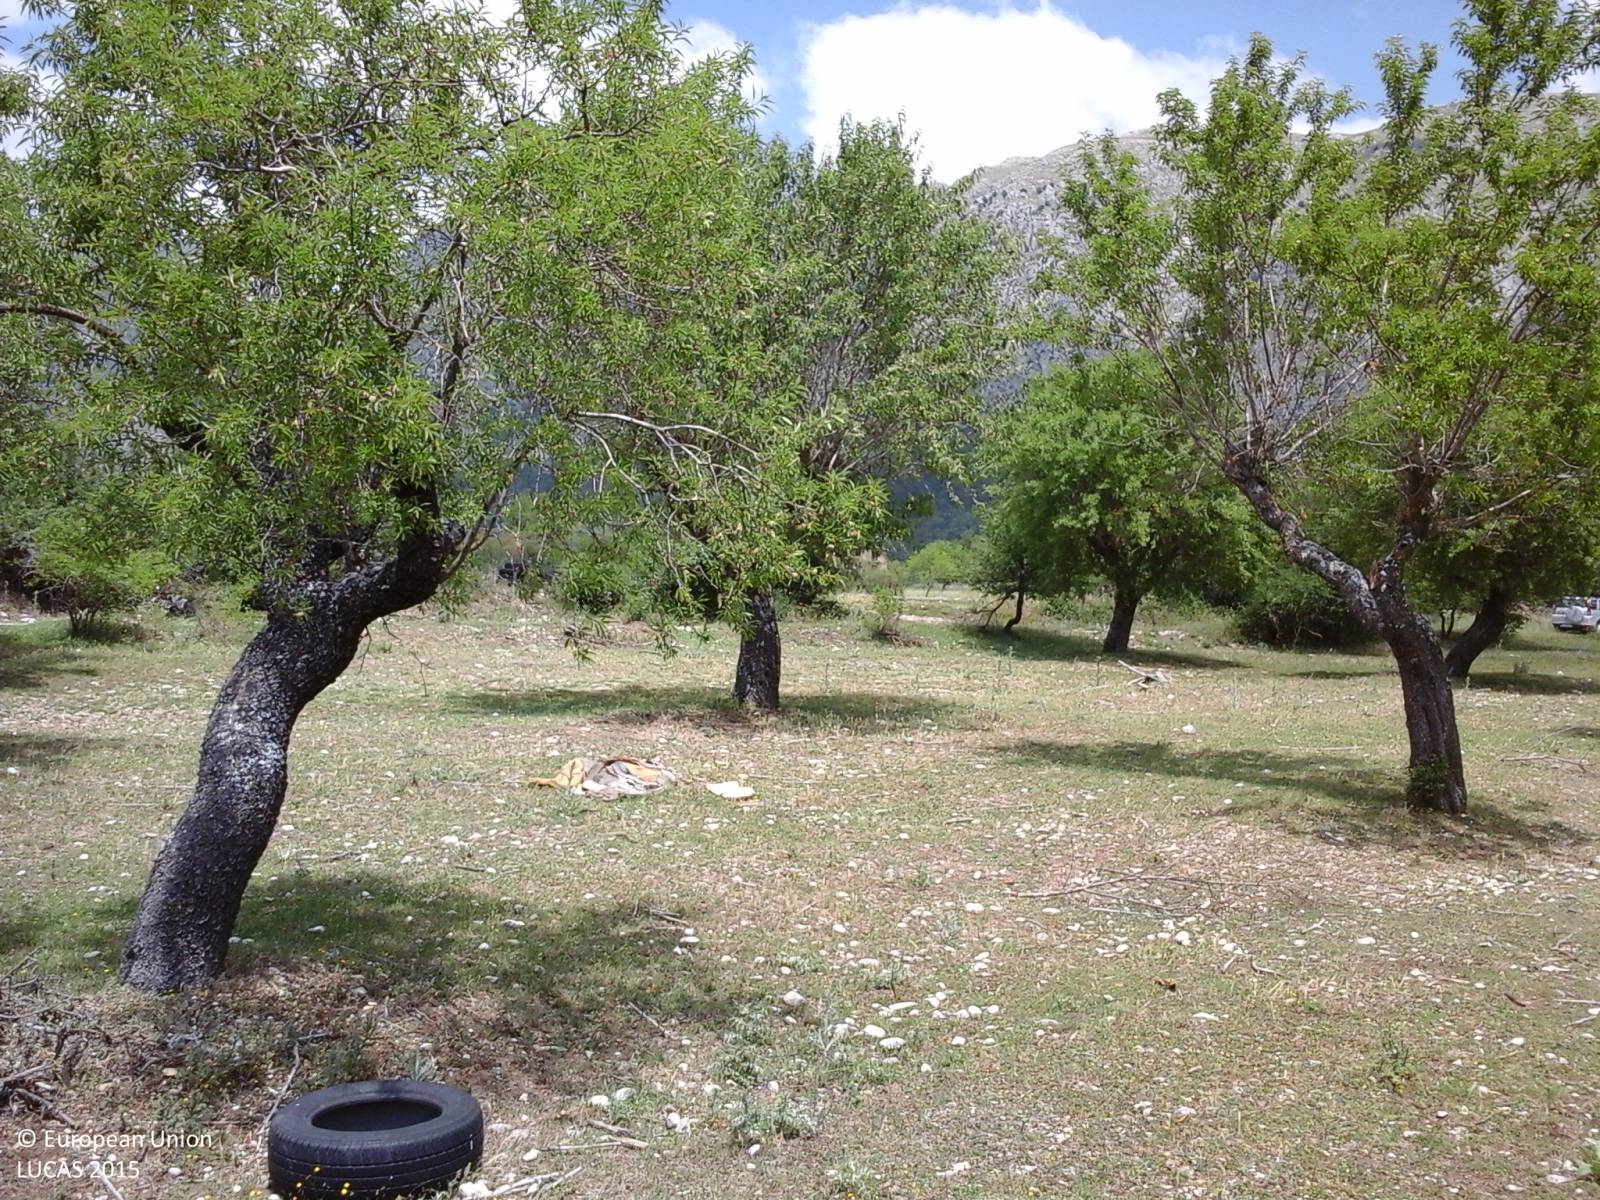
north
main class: Cropland
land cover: Nuts trees
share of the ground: > 75 %
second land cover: Grassland without tree/shrub cover
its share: > 75 %
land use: Agriculture (excluding fallow land and kitchen gardens)
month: June
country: IT
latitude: 42.1076
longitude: 13.4349
